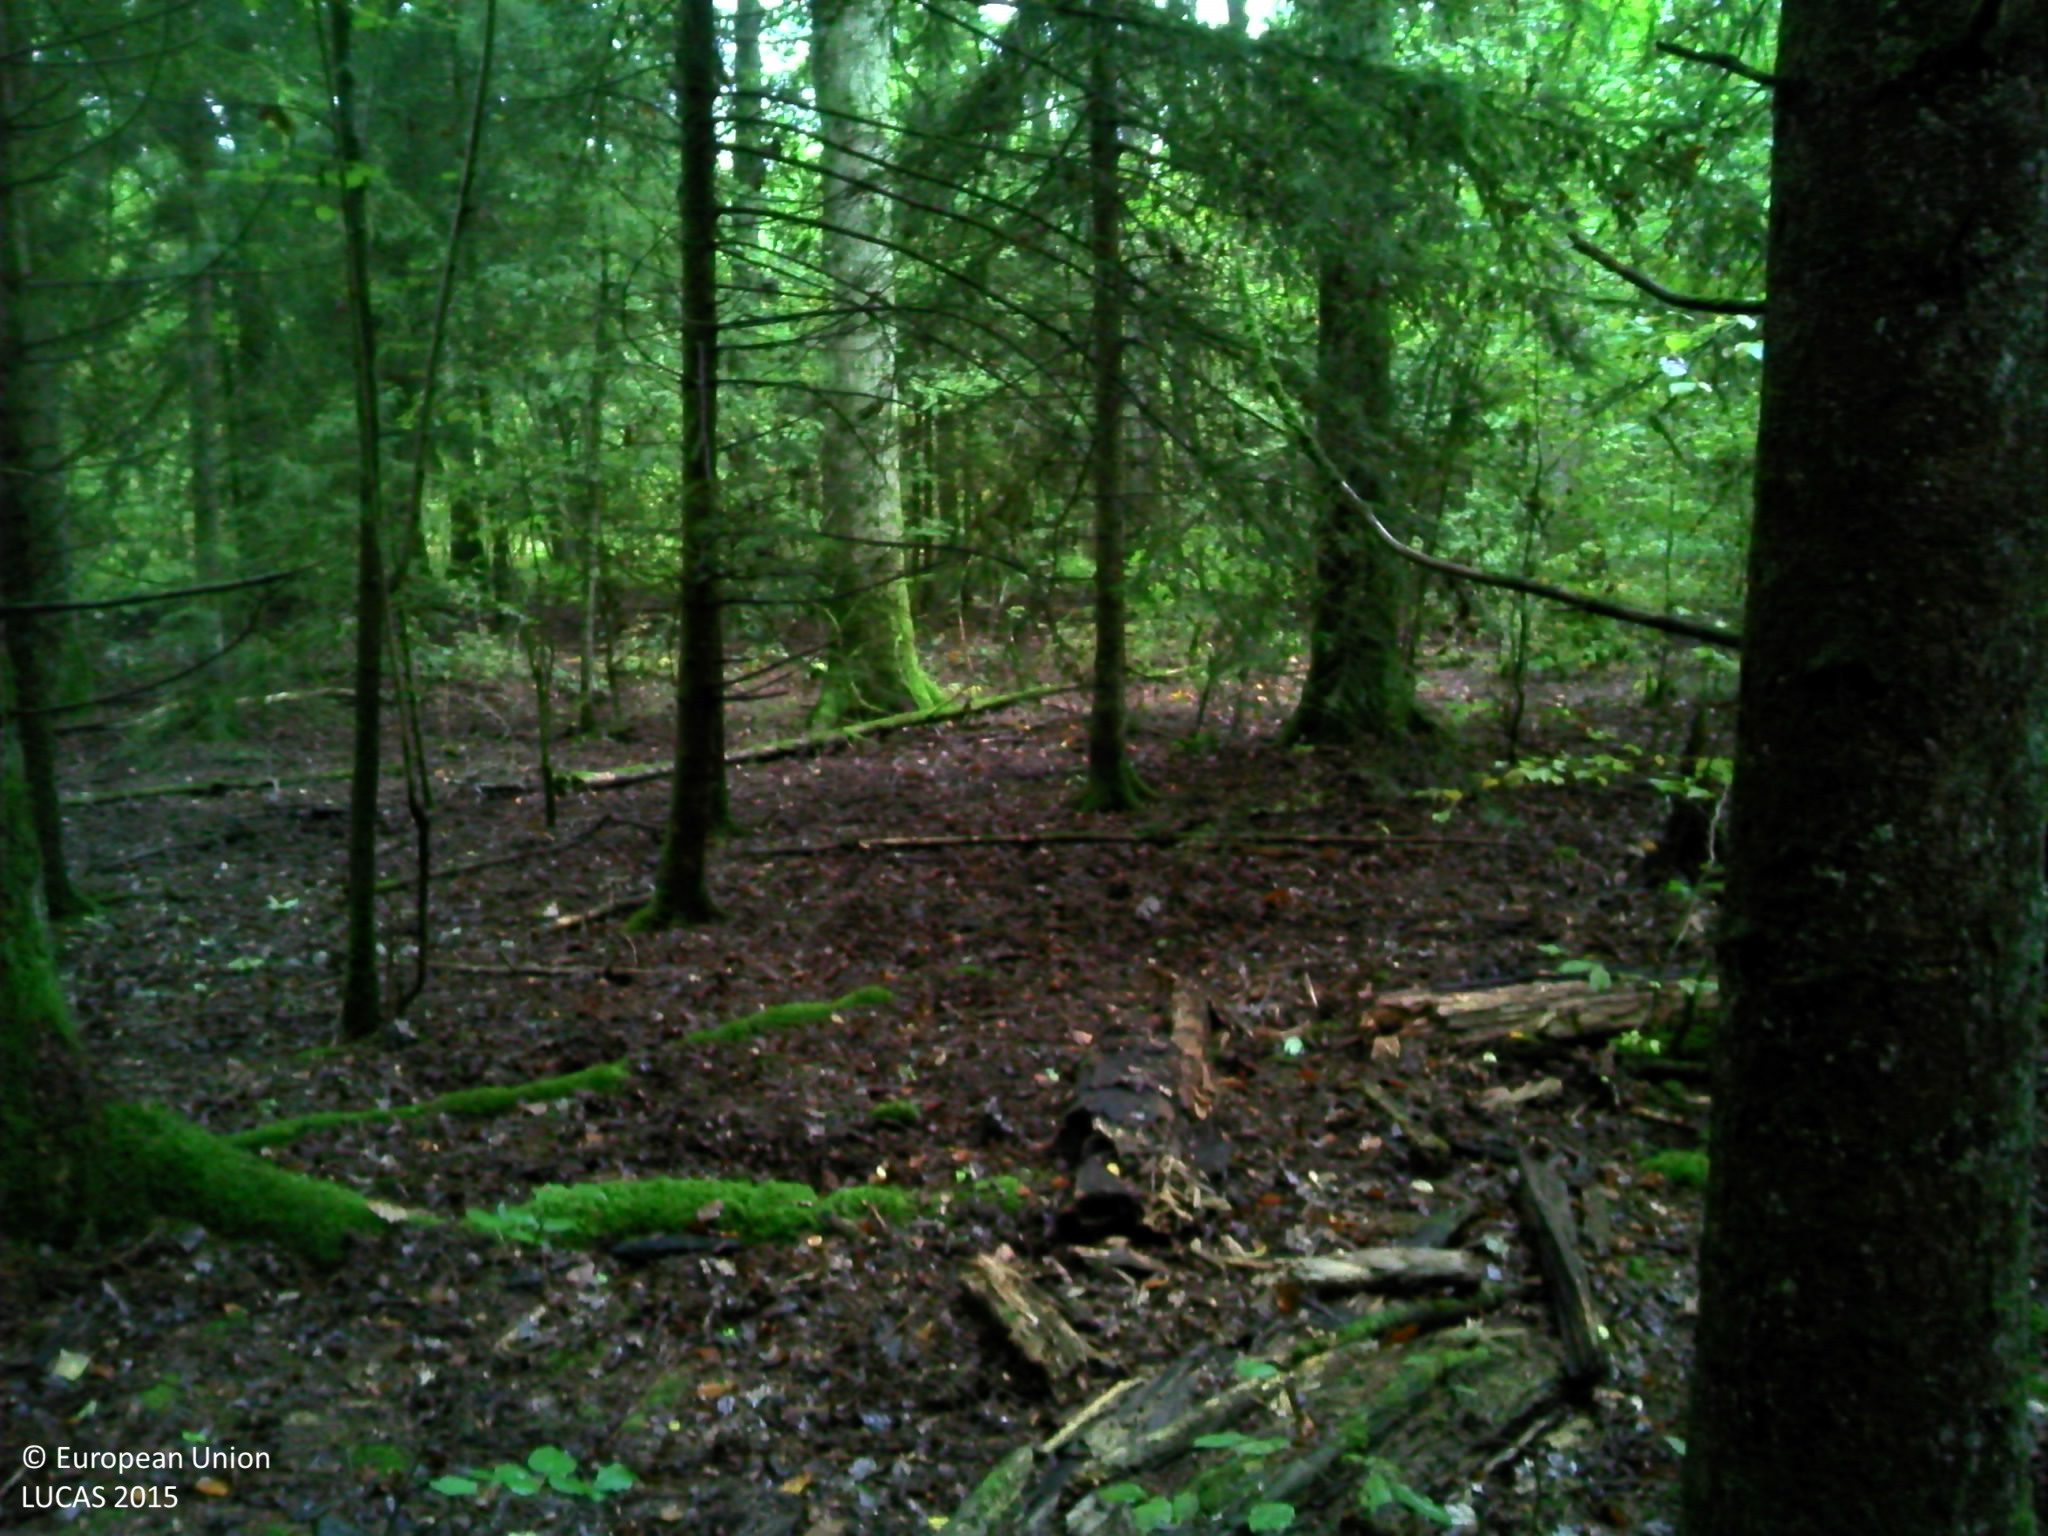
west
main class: Woodland
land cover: Spruce dominated mixed woodland
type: hemiboreal forest and nemoral coniferous forest and mixed broadleaved-coniferous forest
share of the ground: > 75 %
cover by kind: broadleaved forest trees 75 %, coniferous forest trees 25 %
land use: Forestry
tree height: > 5 m
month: October
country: FR
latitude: 48.2027
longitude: 4.3056
